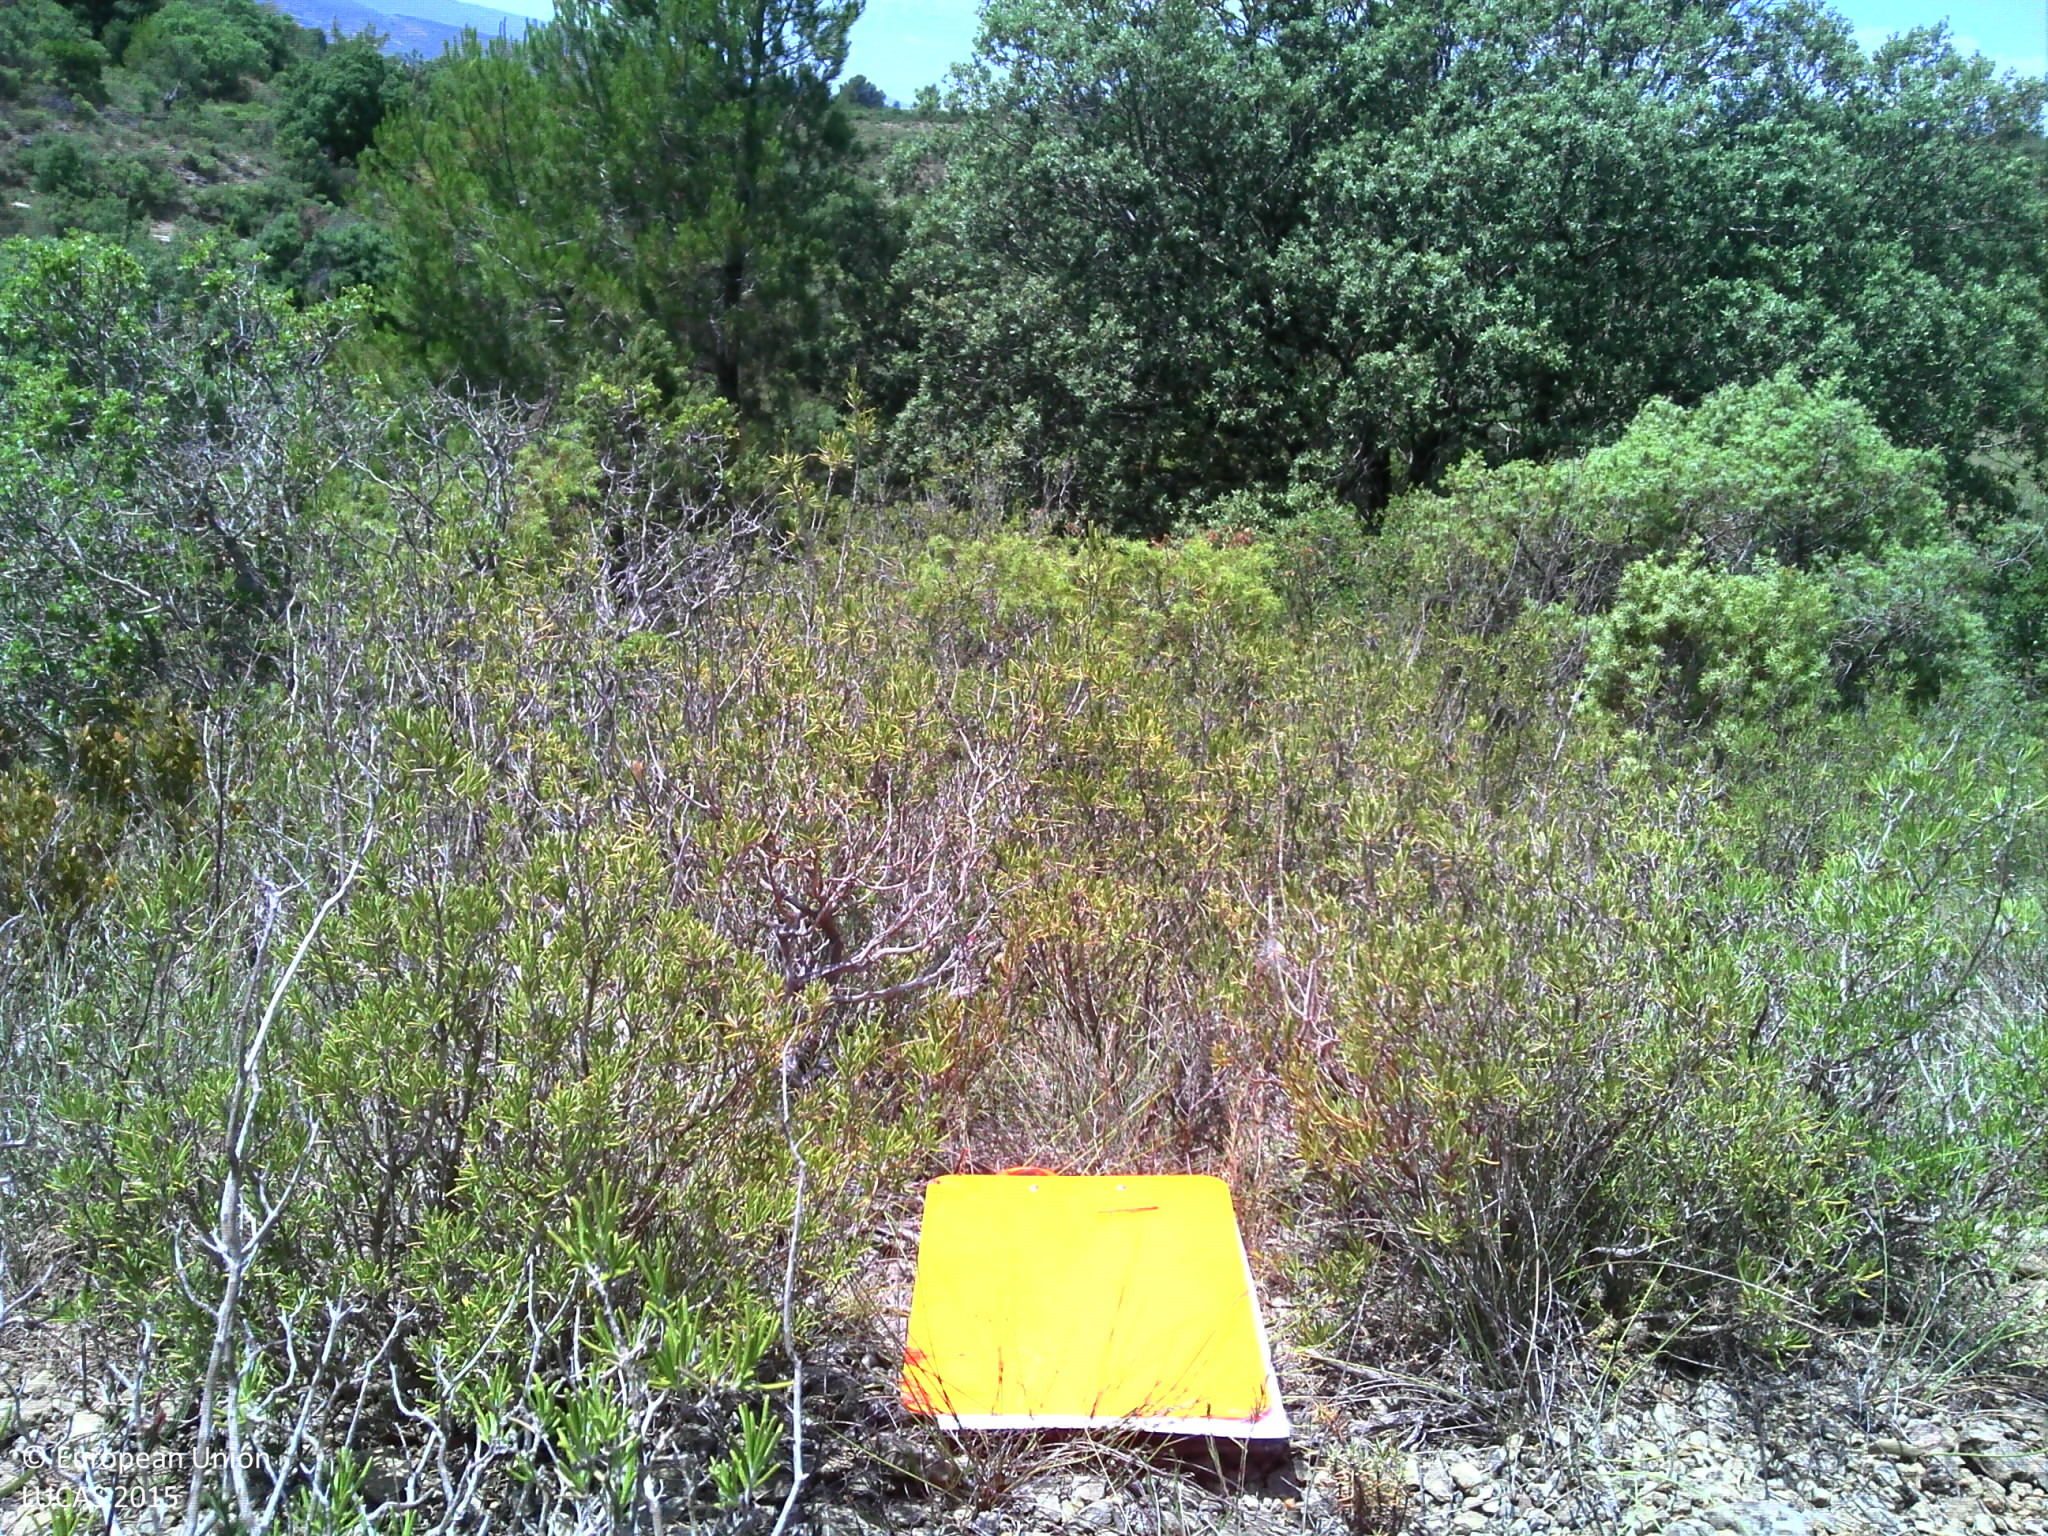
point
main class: Shrubland
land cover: Shrubland with sparse tree cover
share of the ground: > 75 %
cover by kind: shrubs 95 %, broadleaved forest trees 5 %
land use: Semi-natural and natural areas not in use
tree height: < 5 m
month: July
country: FR
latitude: 43.0450
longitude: 2.7304
